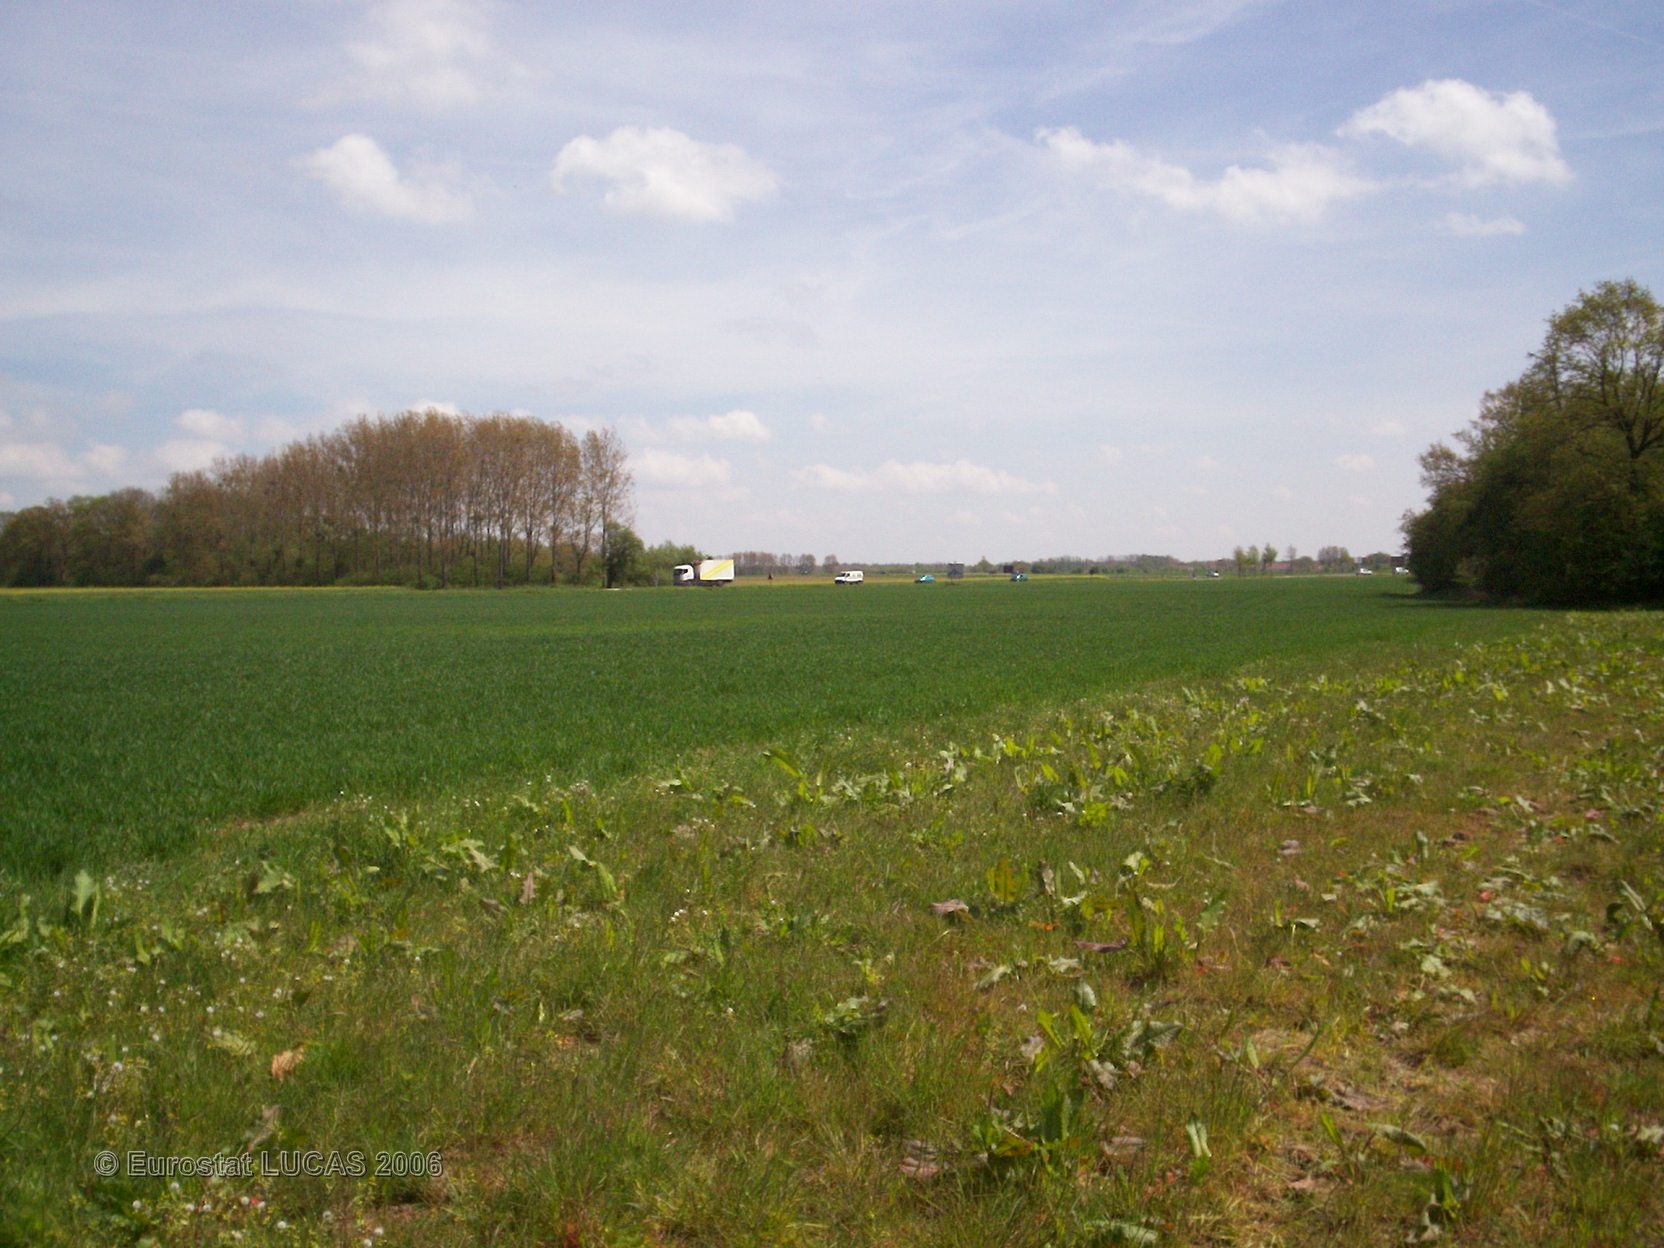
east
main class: Grassland
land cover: Grassland without tree/shrub cover
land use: Agriculture (excluding fallow land and kitchen gardens)
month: May
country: FR
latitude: 48.8197
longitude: 2.8129
